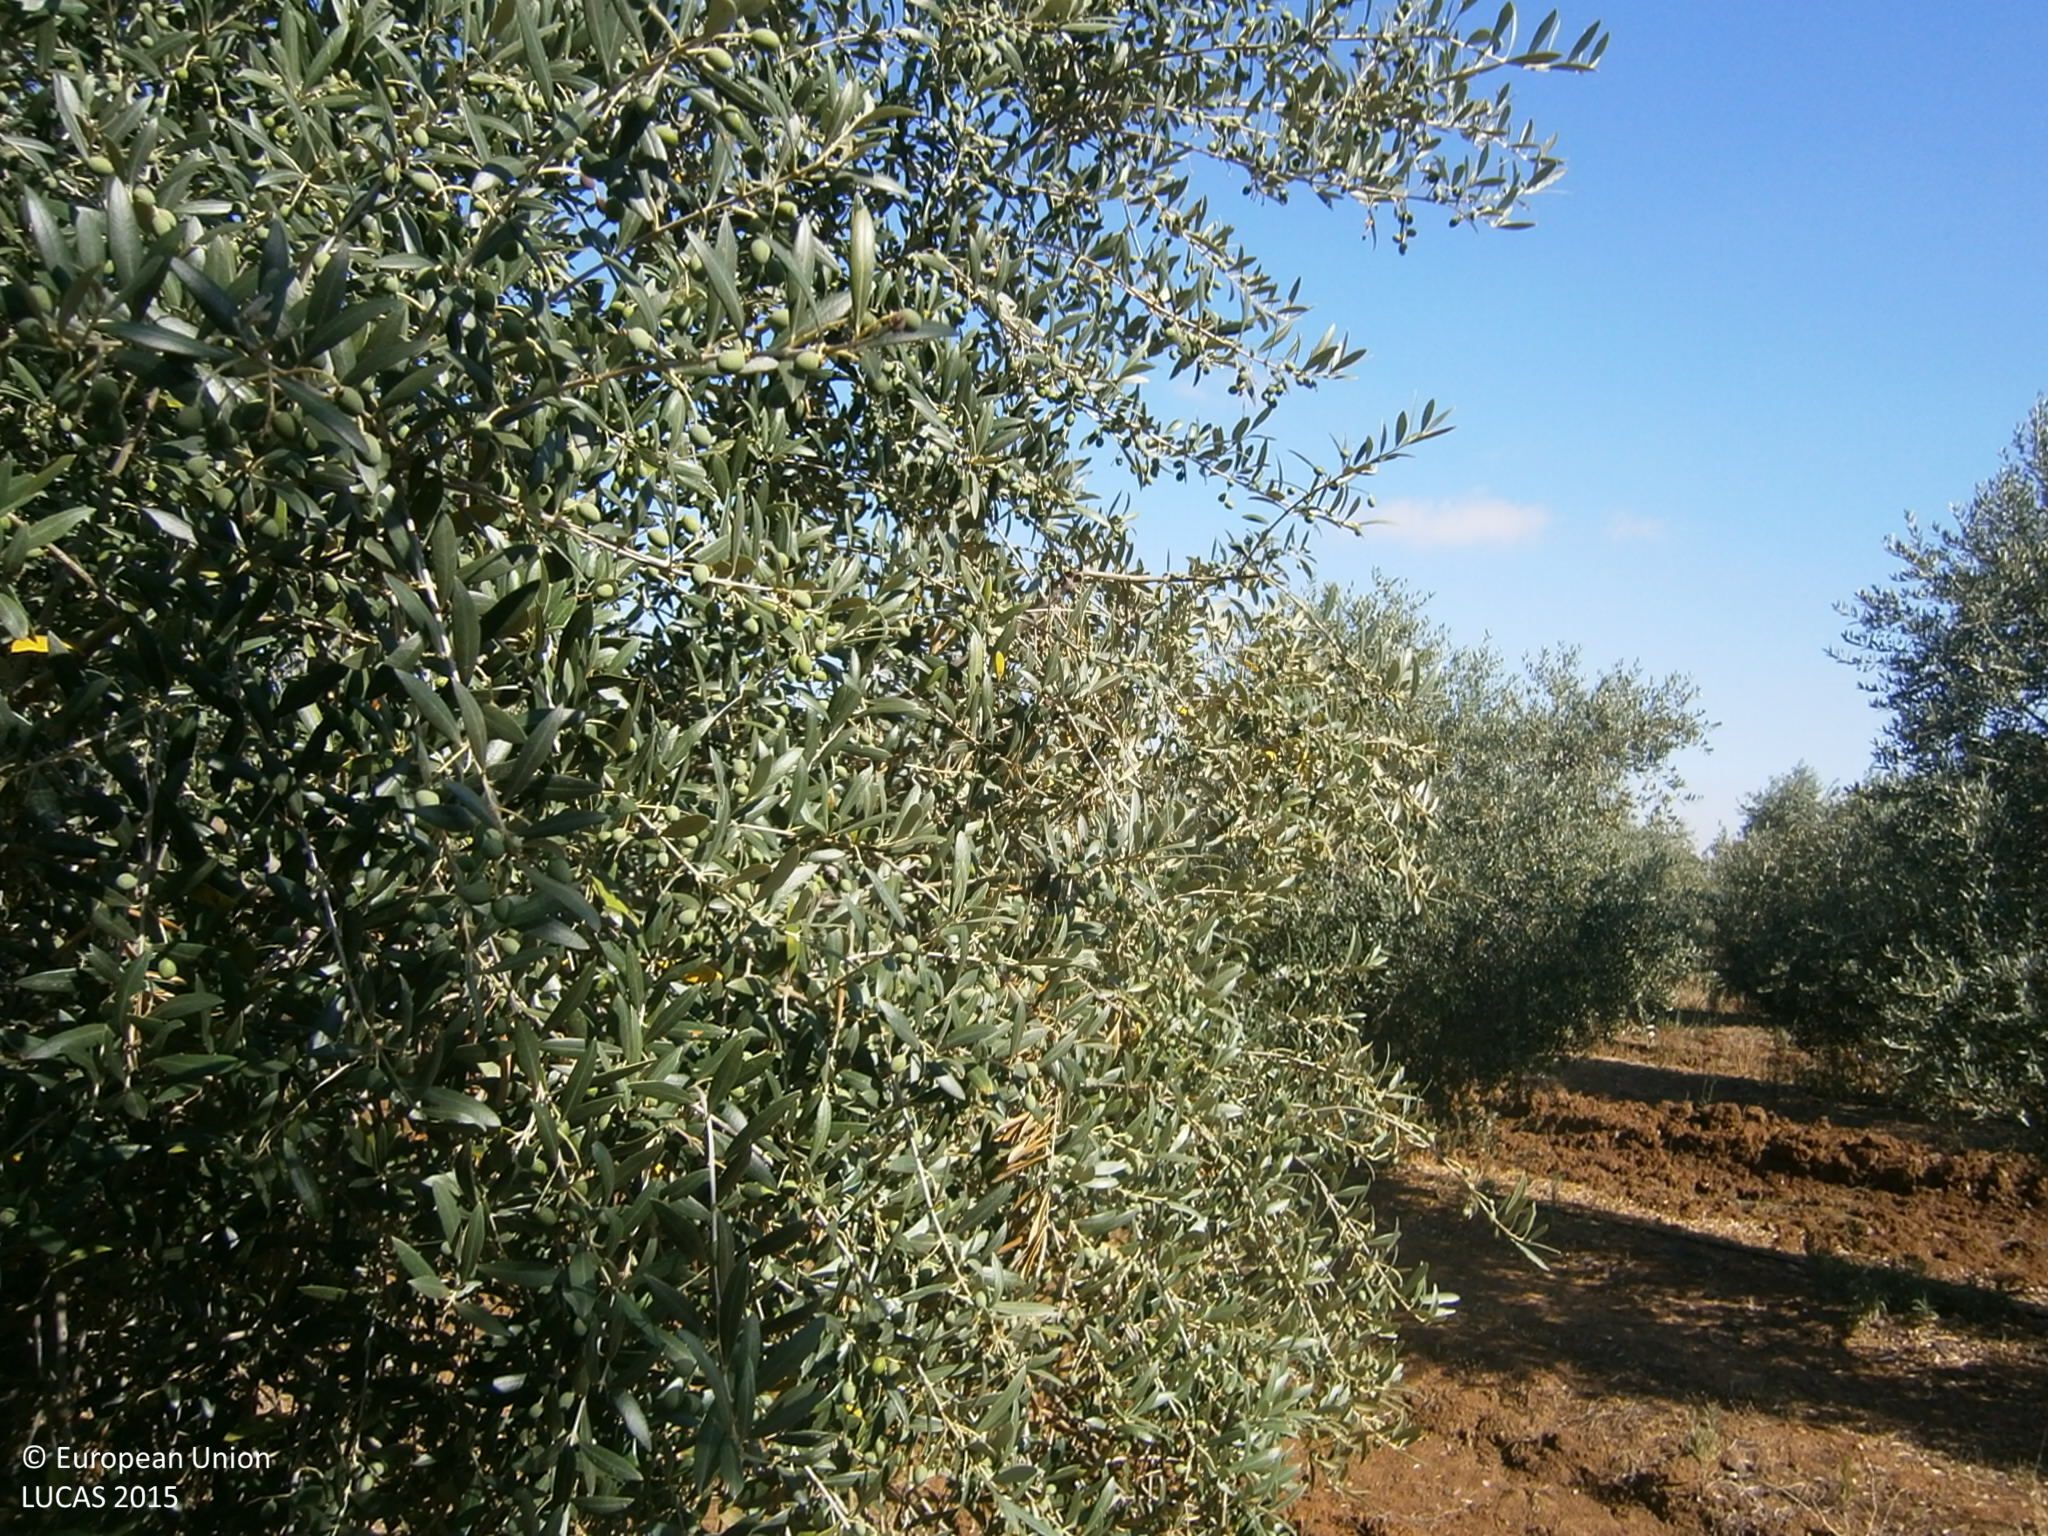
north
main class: Cropland
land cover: Olive groves
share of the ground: 25 - 50 %
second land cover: Spontaneously vegetated surfaces
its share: 10 - 25 %
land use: Agriculture (excluding fallow land and kitchen gardens)
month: June
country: ES
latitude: 38.6777
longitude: -6.9045
